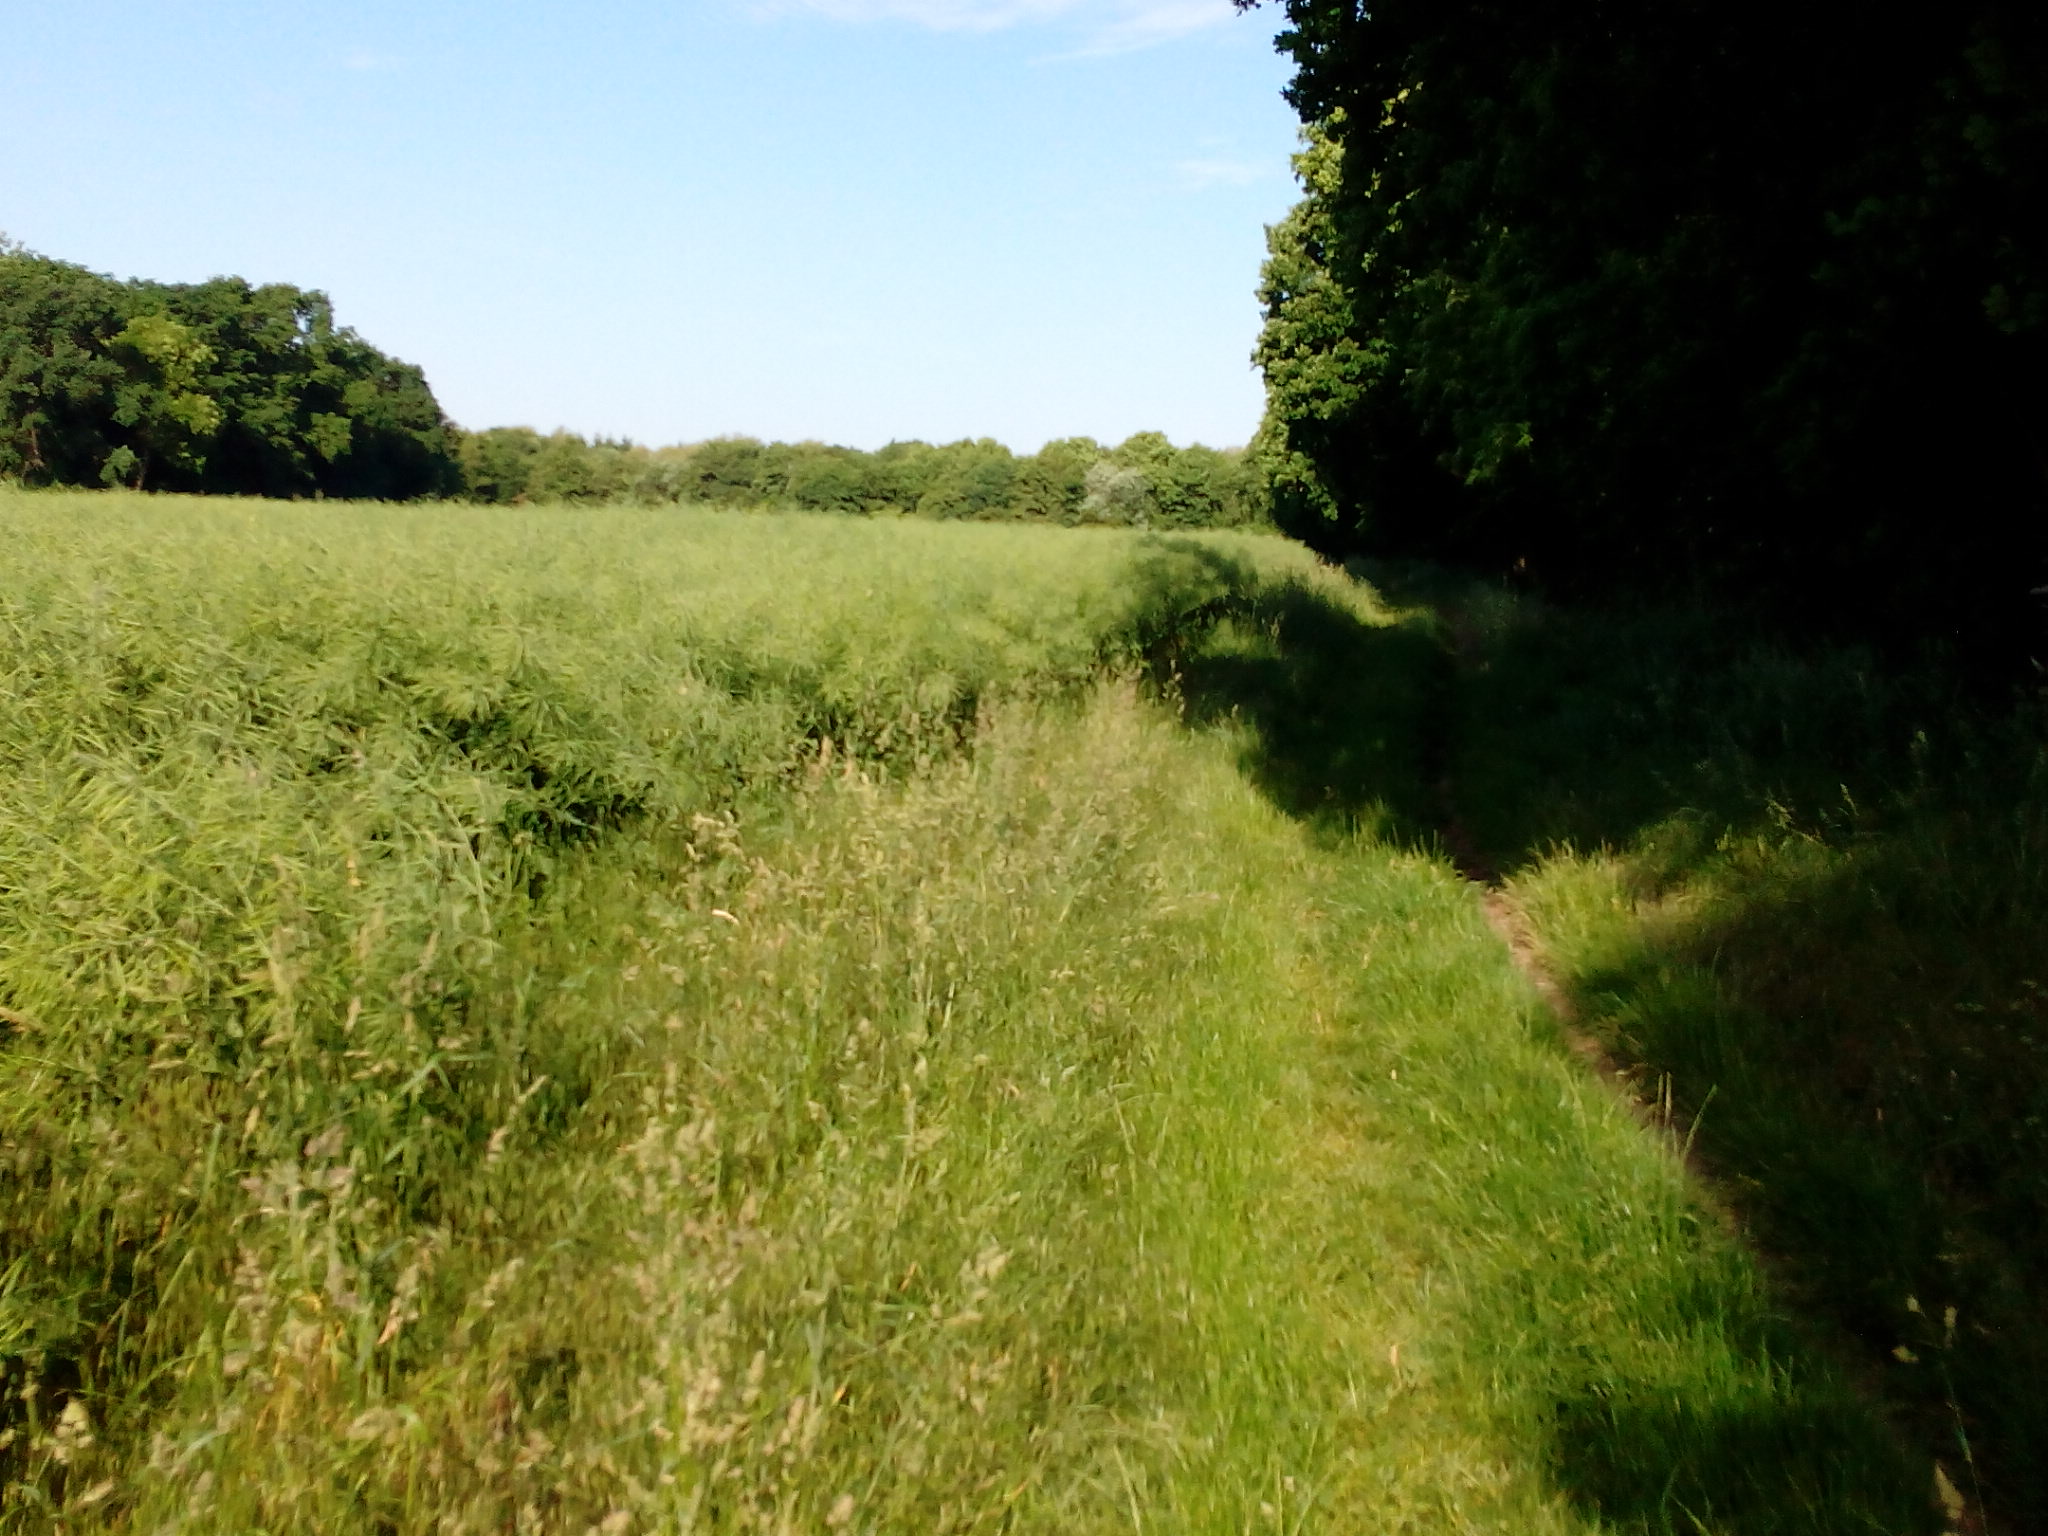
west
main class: Cropland
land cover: Rape and turnip rape
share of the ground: > 75 %
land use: Agriculture (excluding fallow land and kitchen gardens)
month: June
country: DE
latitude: 52.3235
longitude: 9.9267
